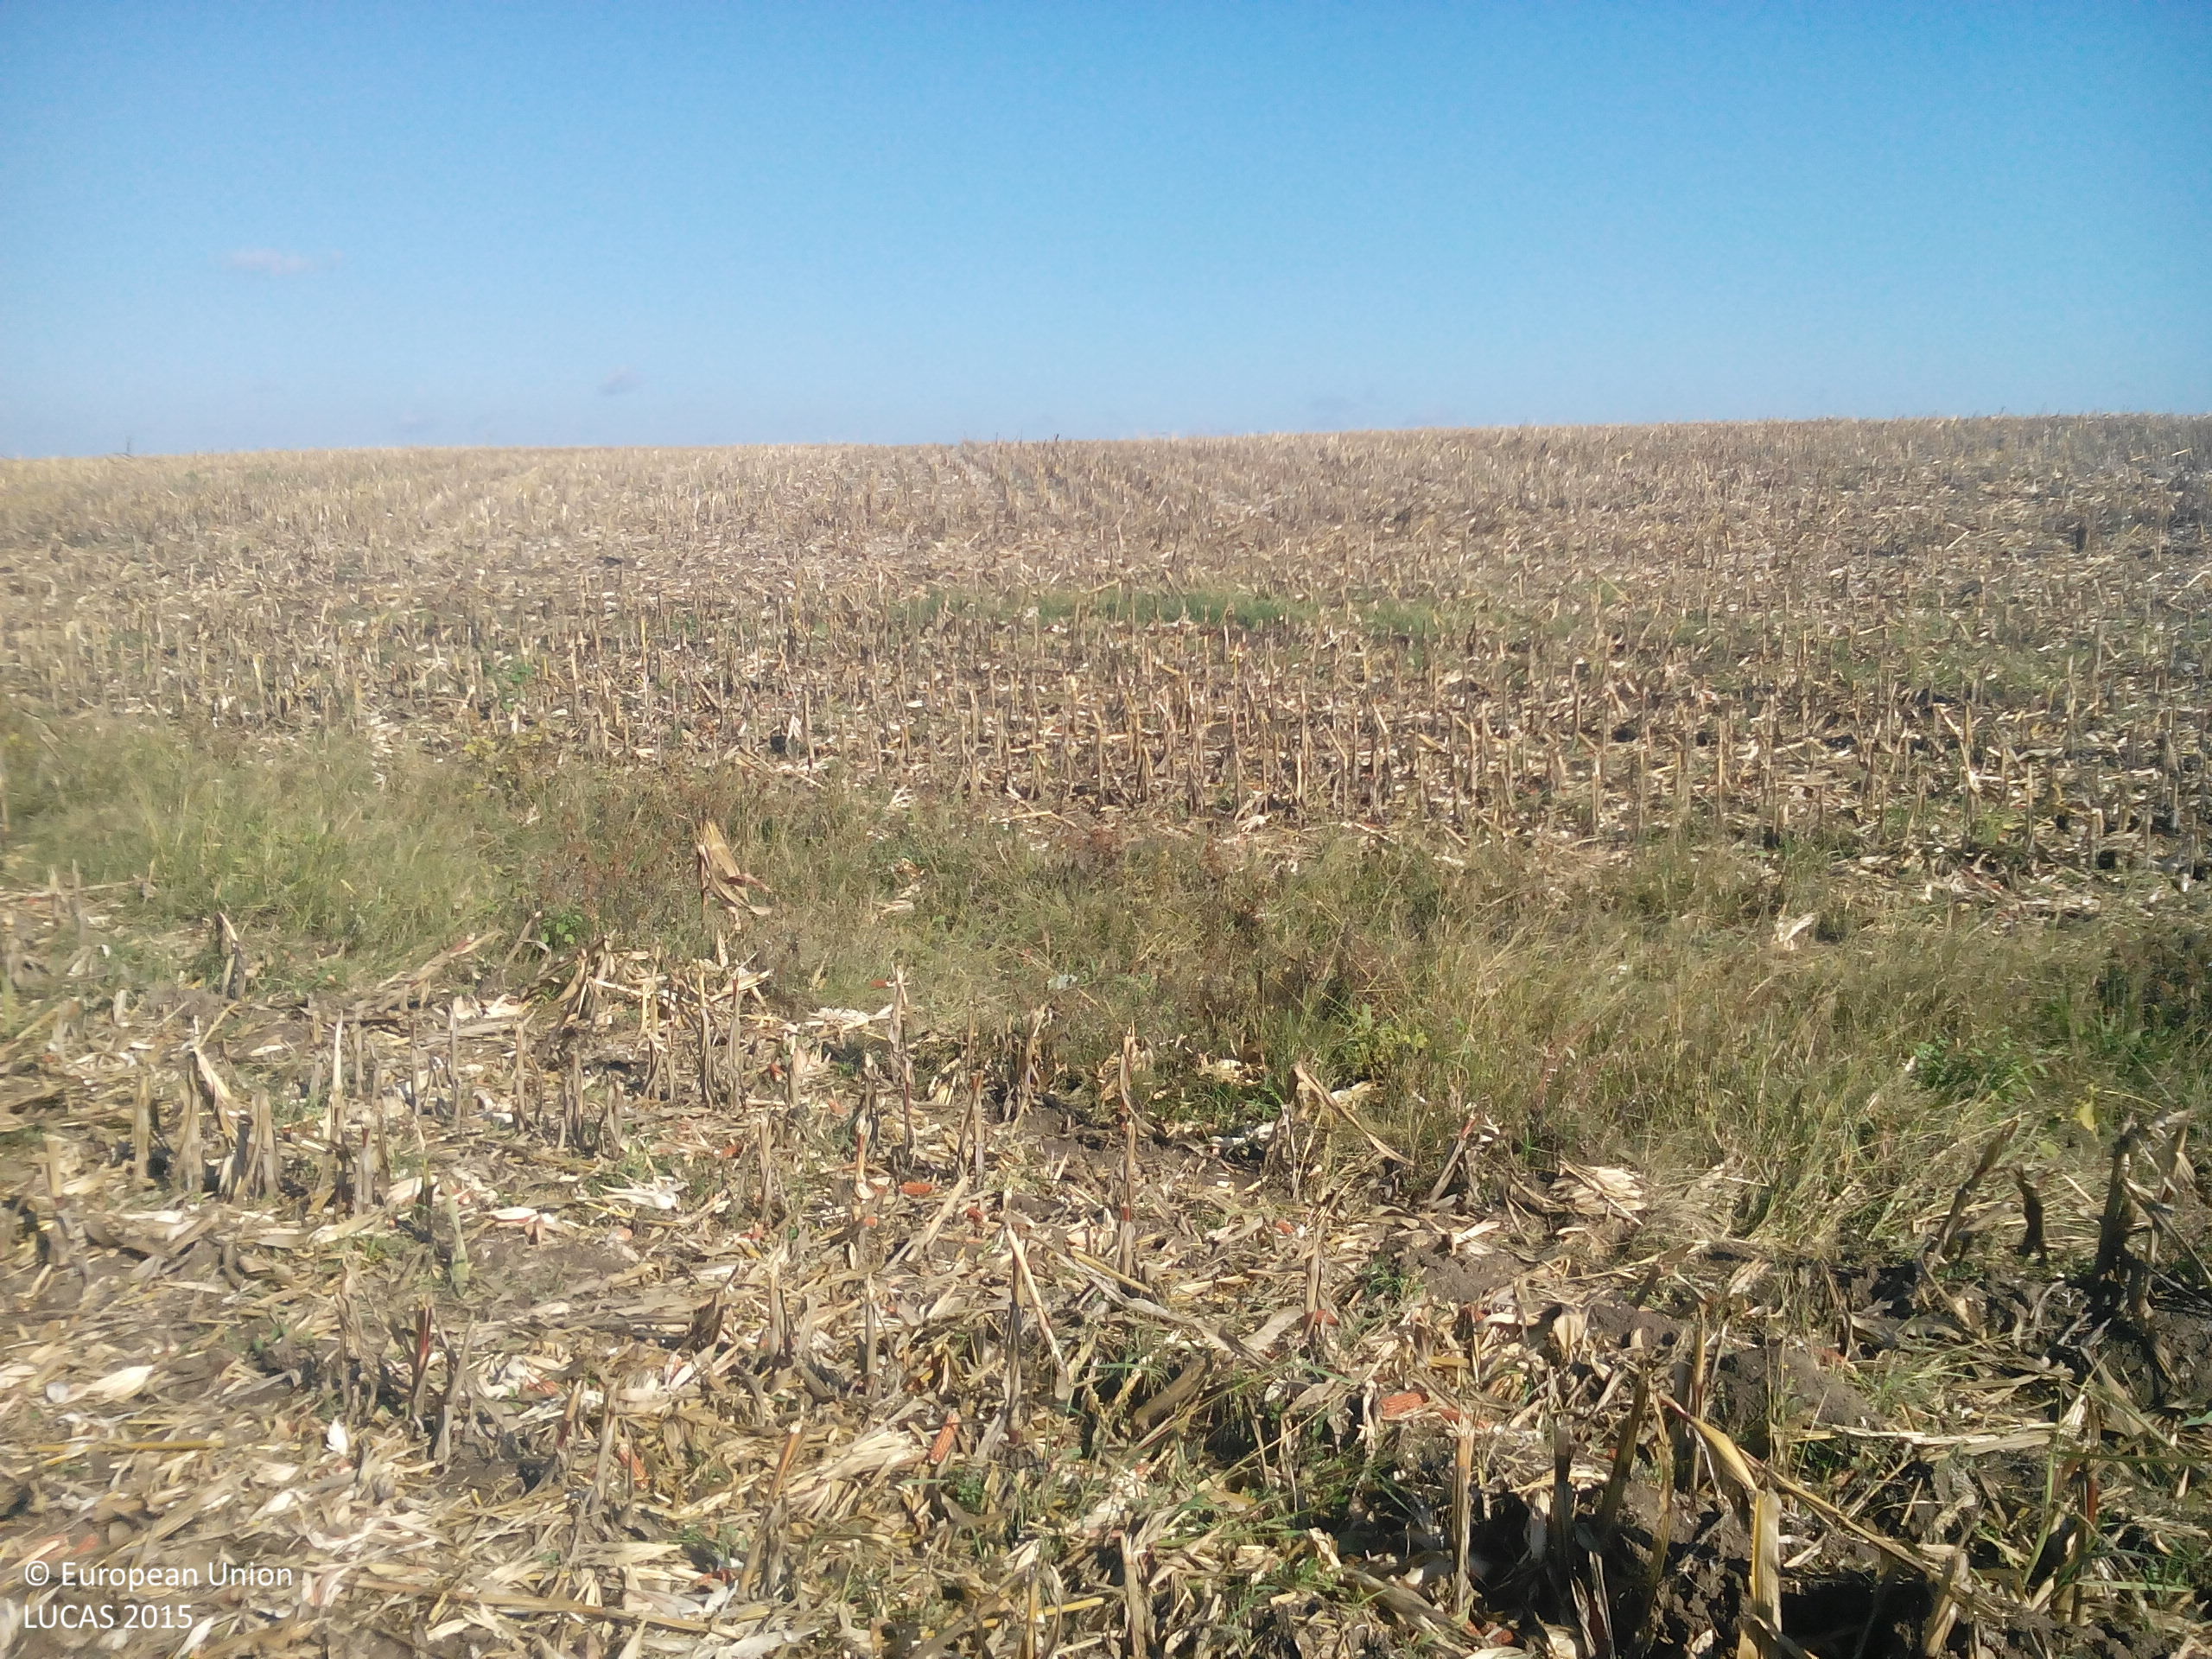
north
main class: Cropland
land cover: Maize
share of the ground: 10 - 25 %
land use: Agriculture (excluding fallow land and kitchen gardens)
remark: Harvested field
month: October
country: BG
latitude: 43.3918
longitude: 23.7636
